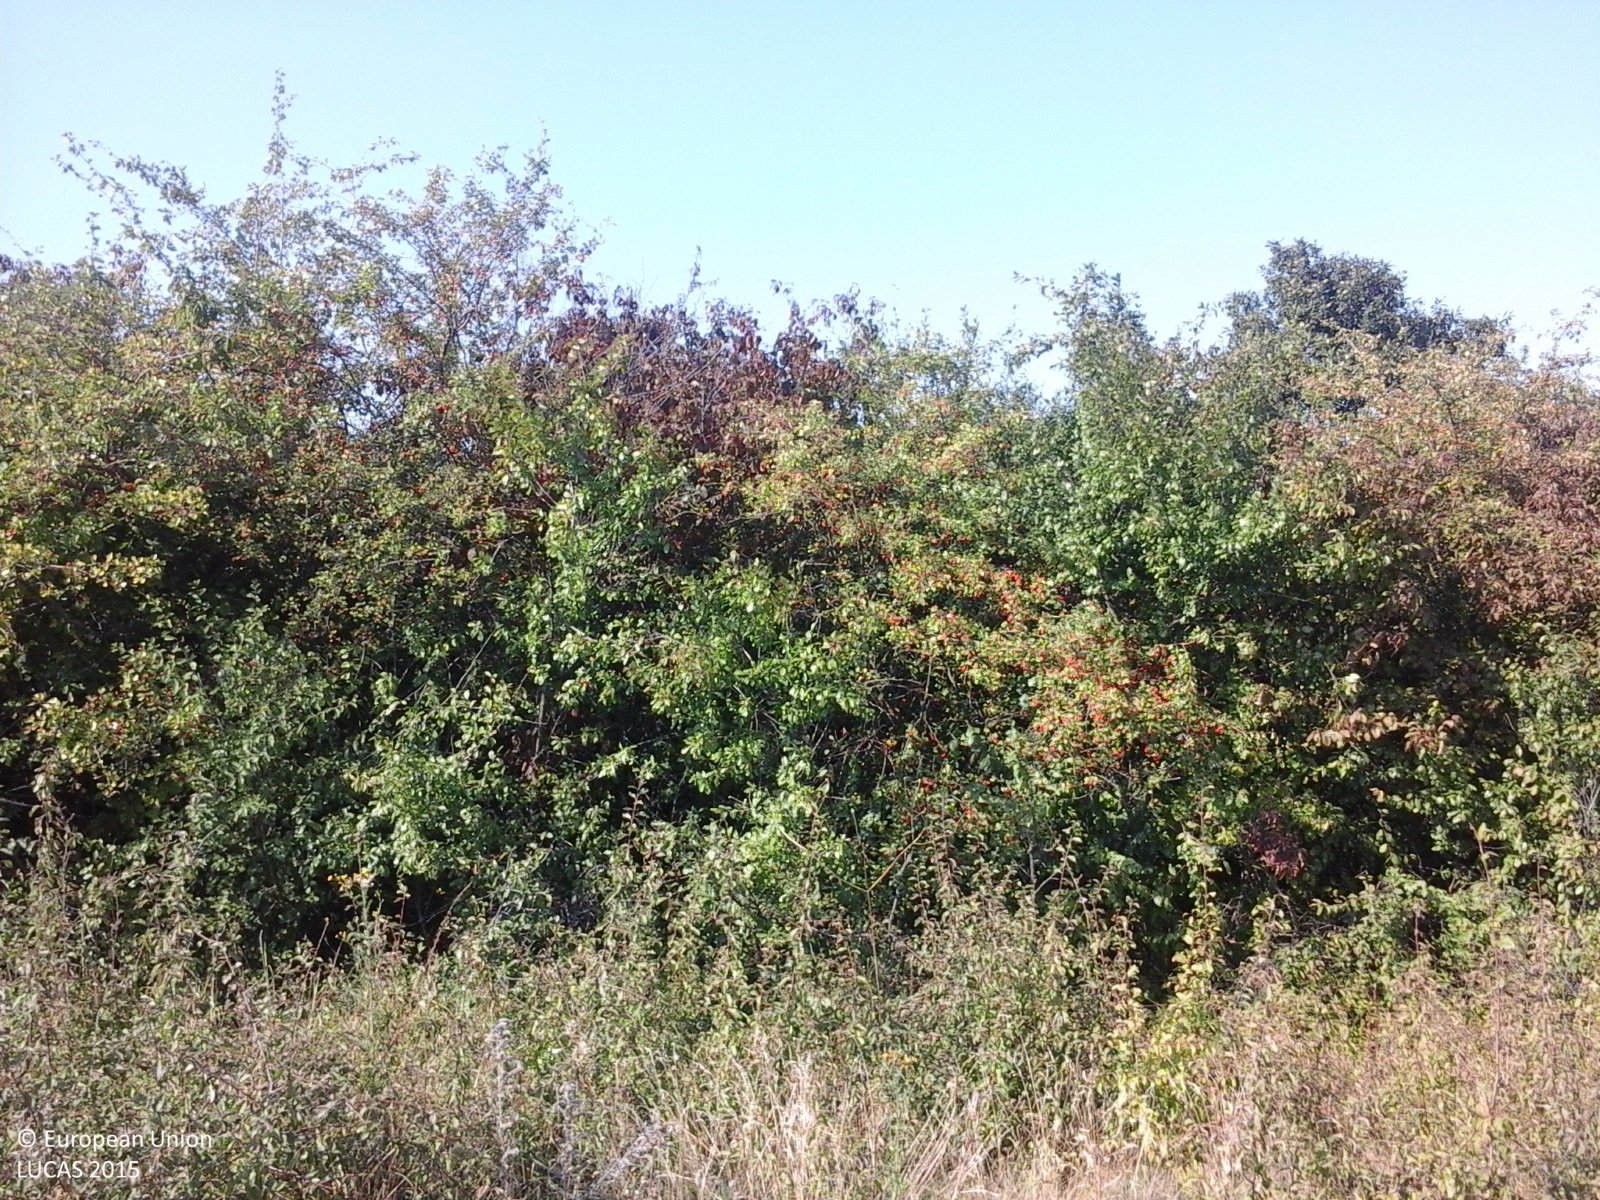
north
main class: Cropland
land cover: Maize
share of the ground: > 75 %
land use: Agriculture (excluding fallow land and kitchen gardens)
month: September
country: RO
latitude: 47.2691
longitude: 22.6813
